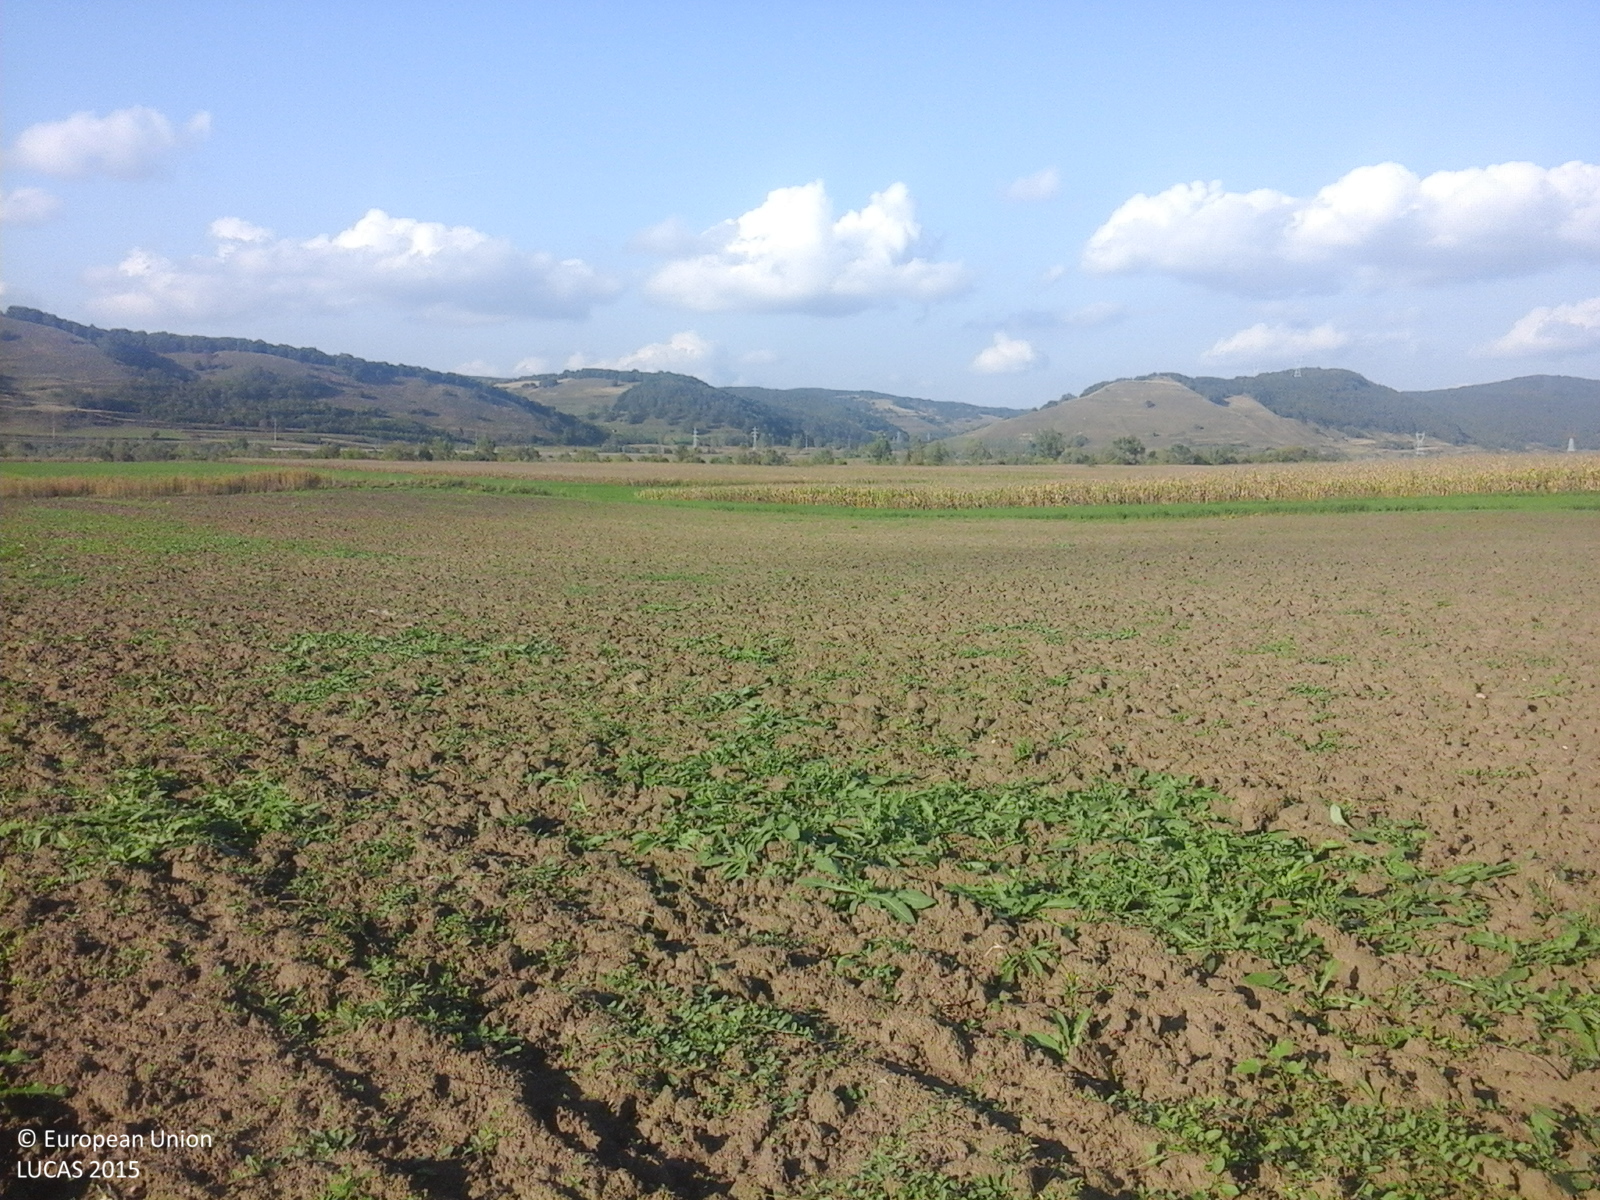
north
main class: Grassland
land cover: Spontaneously vegetated surfaces
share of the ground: > 75 %
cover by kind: herbaceous plants 100 %
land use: Agriculture (excluding fallow land and kitchen gardens)
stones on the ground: < 10 %
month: October
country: RO
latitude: 46.0831
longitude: 24.1335
